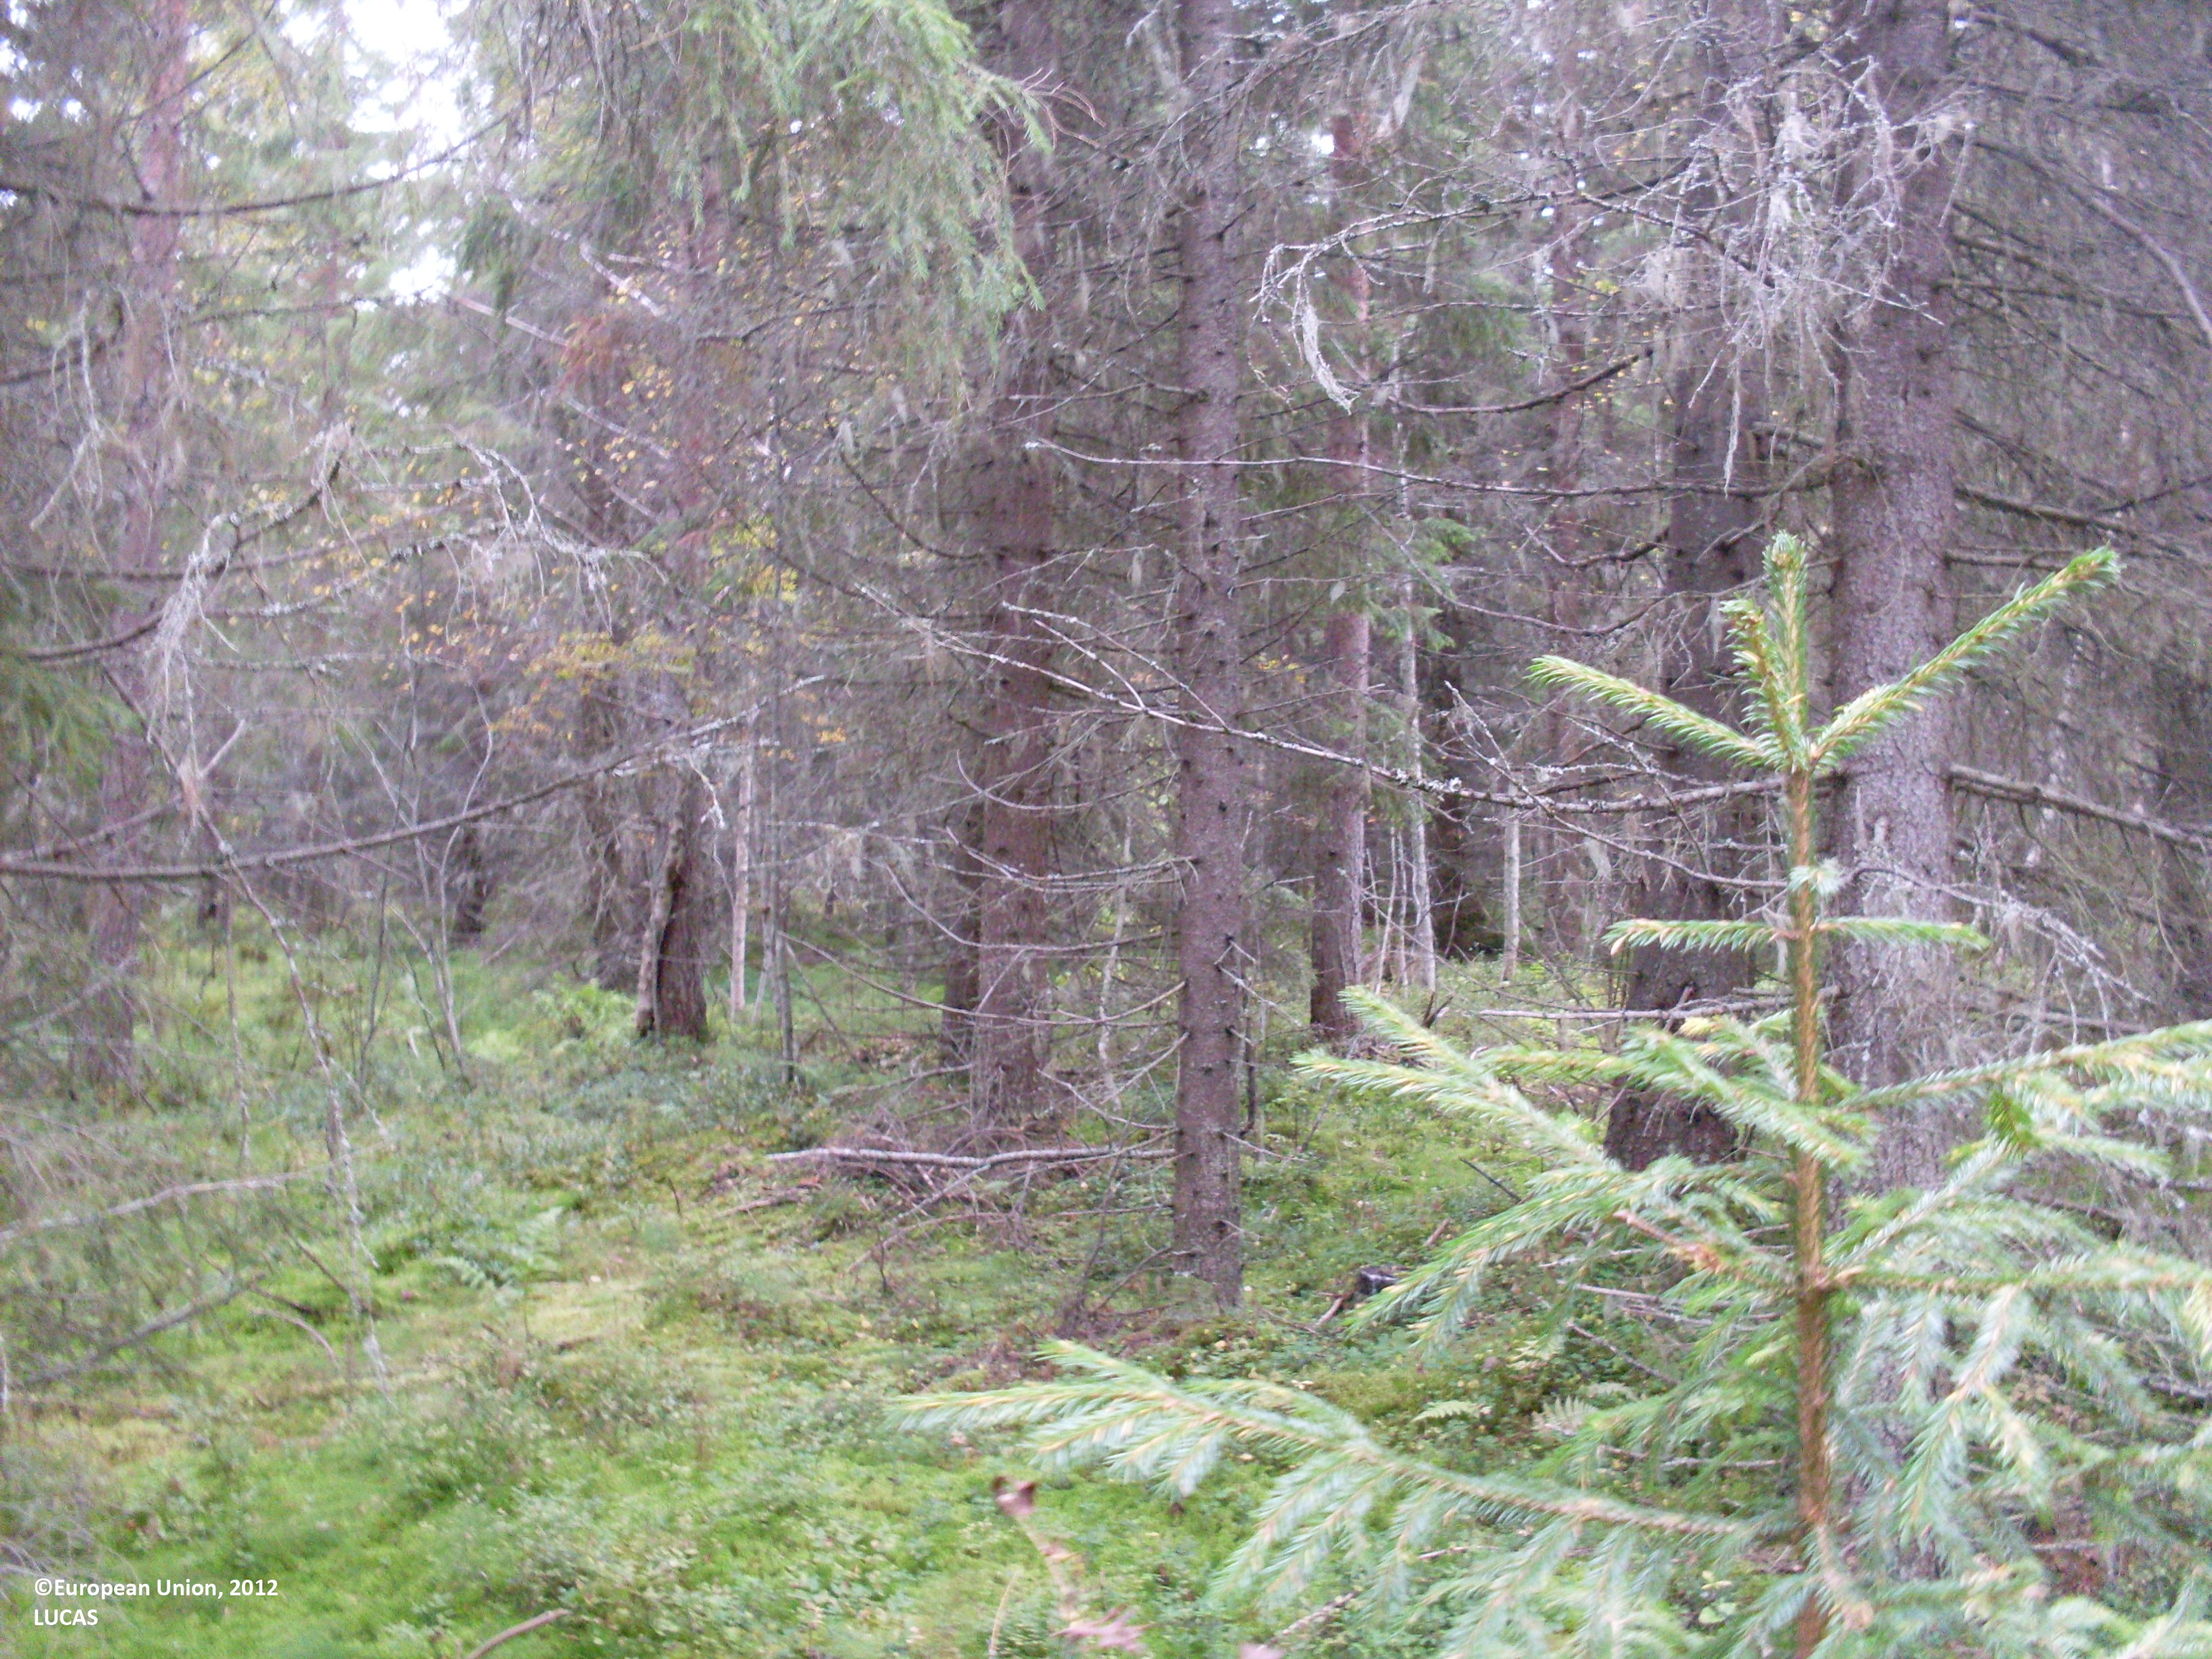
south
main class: Woodland
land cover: Spruce dominated mixed woodland
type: boreal forest
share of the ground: 50 - 75 %
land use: Forestry
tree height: > 5 m
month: September
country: FI
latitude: 64.1501
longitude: 28.3684
